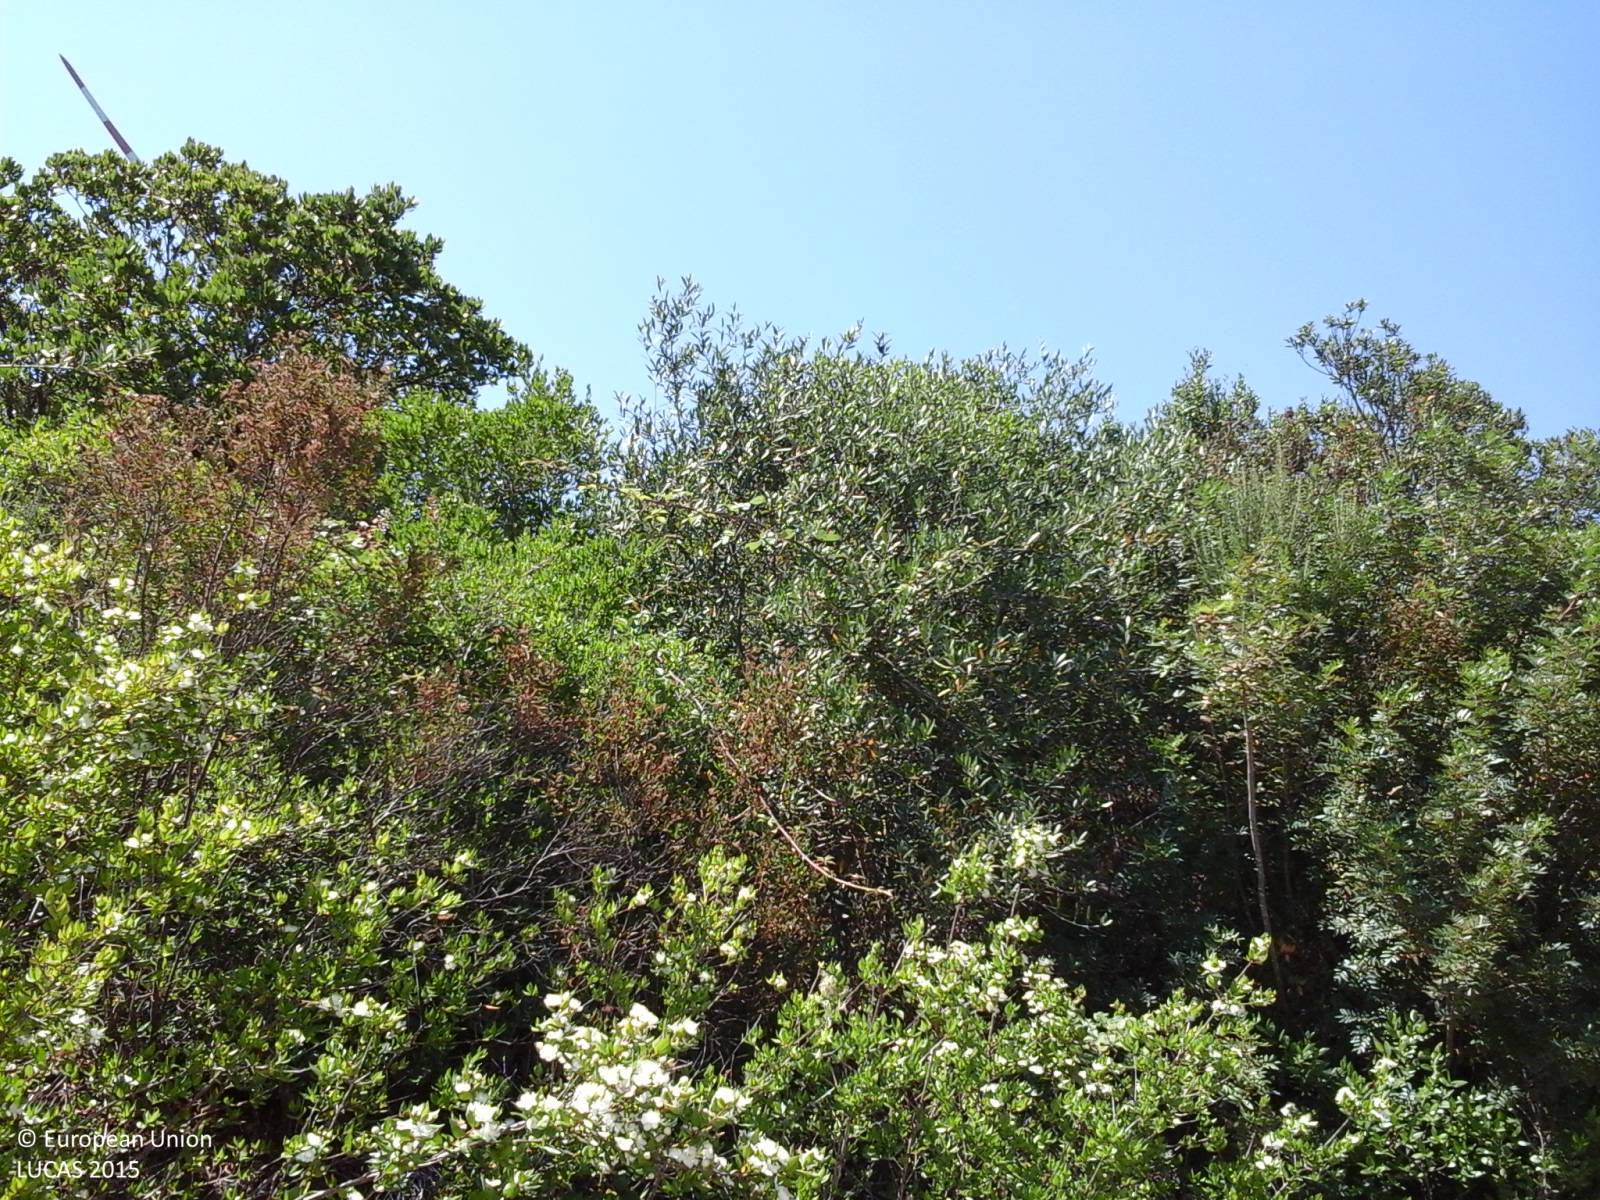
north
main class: Woodland
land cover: Broadleaved woodland
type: broadleaved evergreen forest
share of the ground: > 75 %
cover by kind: broadleaved forest trees 100 %
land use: Semi-natural and natural areas not in use
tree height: < 5 m
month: June
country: IT
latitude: 39.8984
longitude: 8.8485
